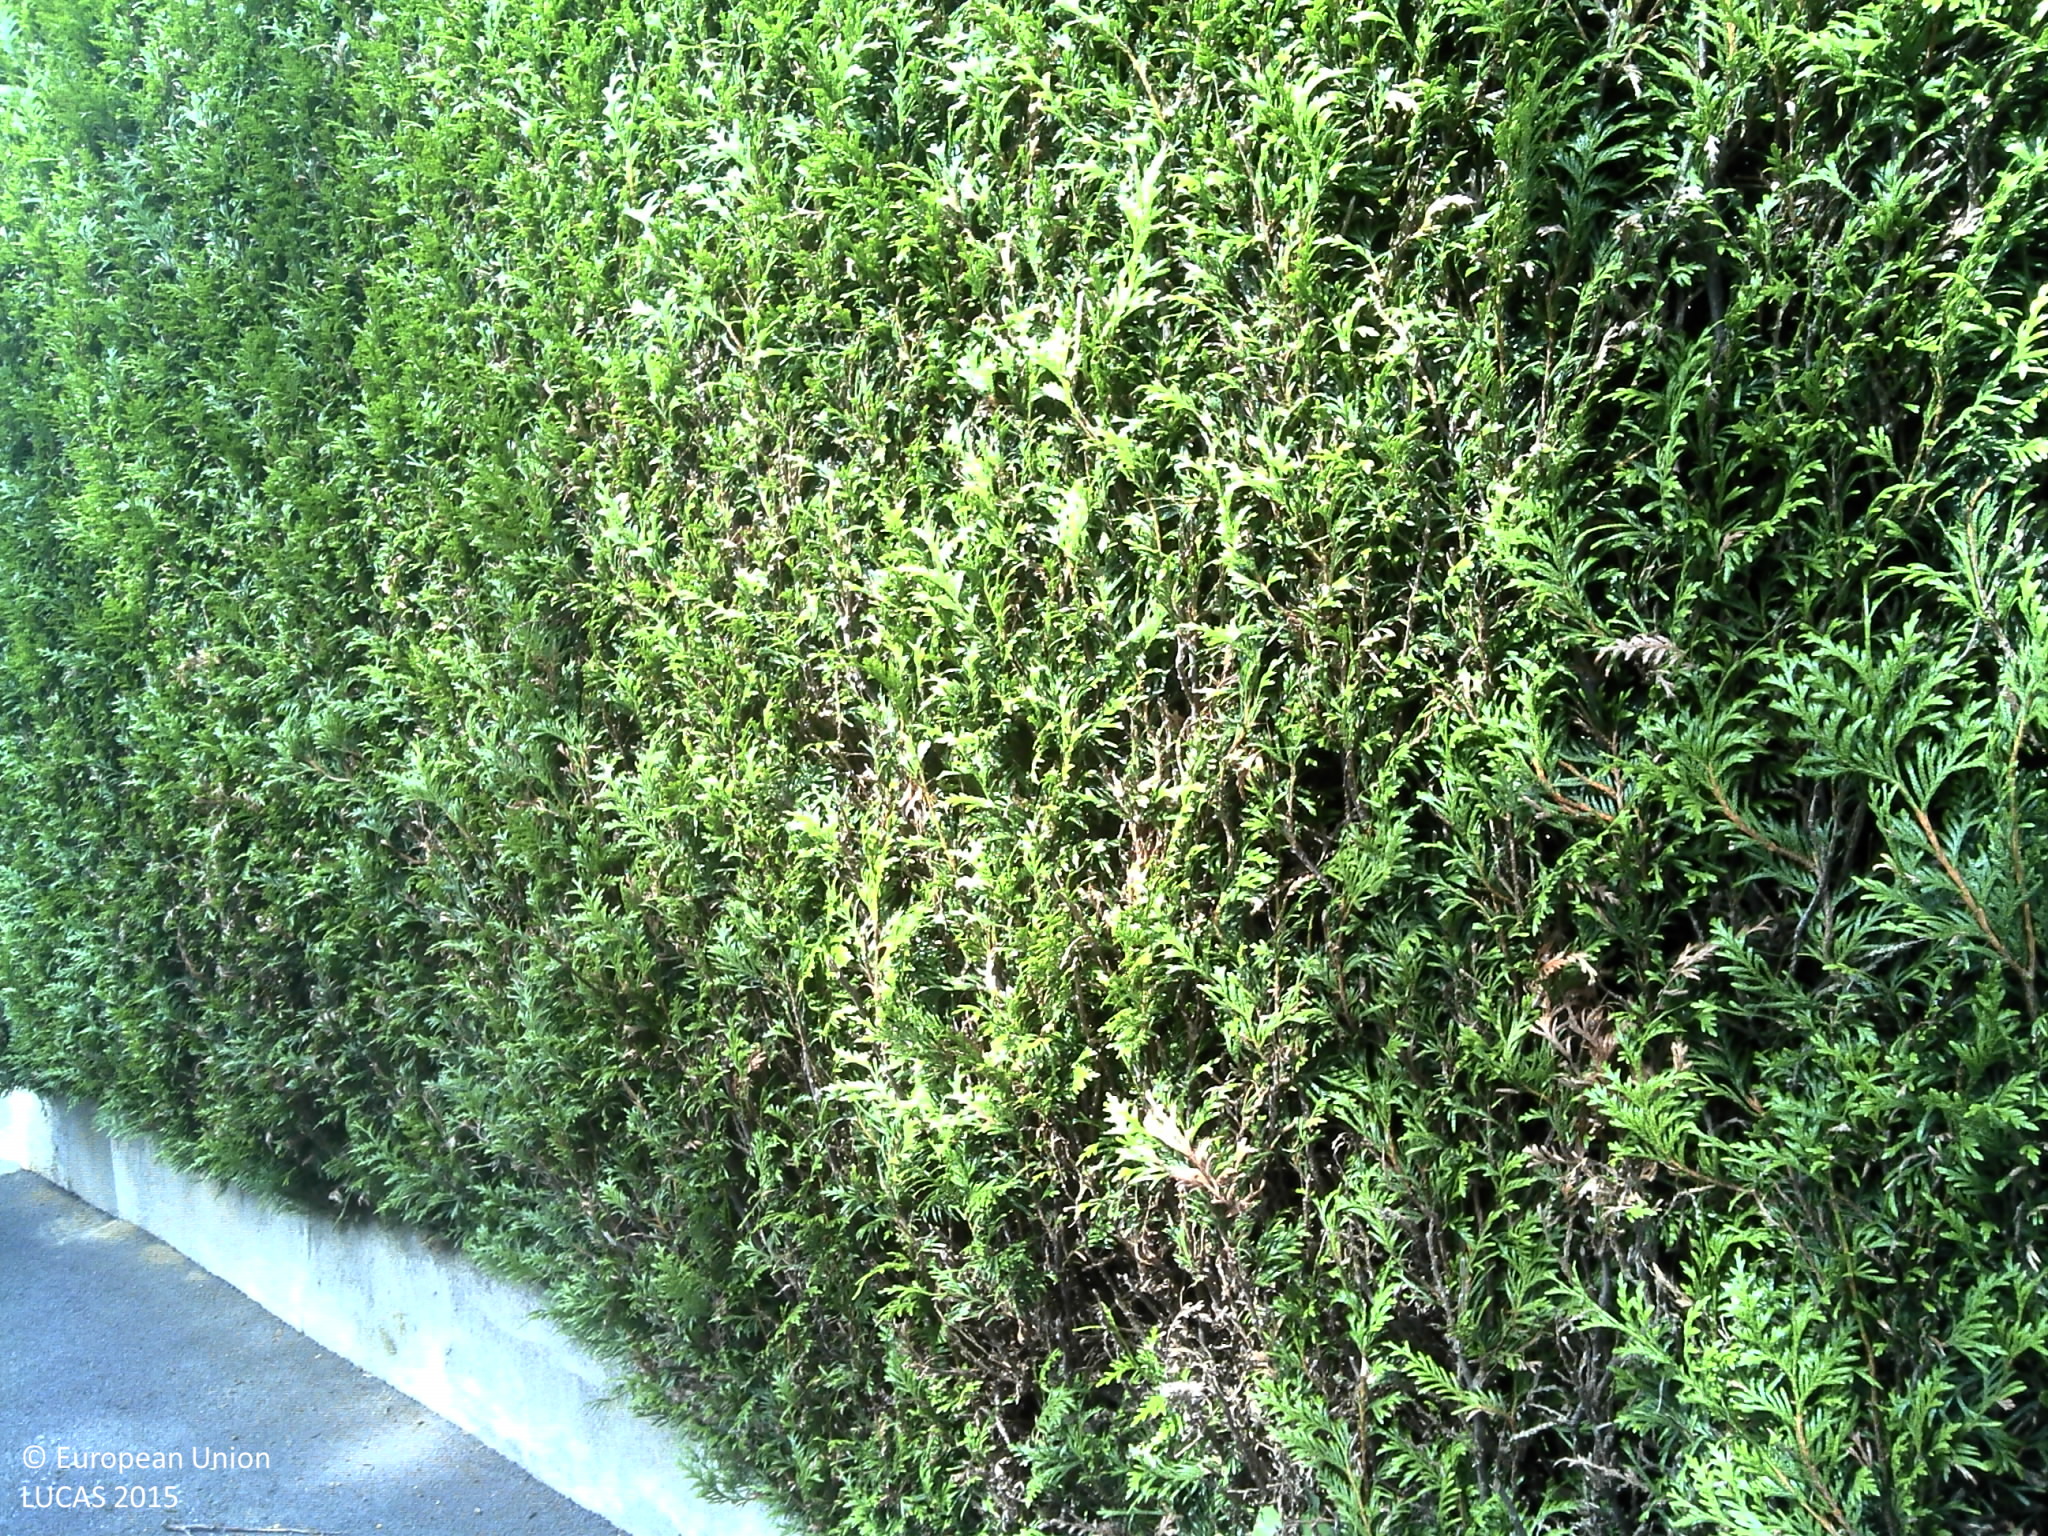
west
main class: Grassland
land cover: Grassland with sparse tree/shrub cover
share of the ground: > 75 %
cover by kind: herbaceous plants 95 %, broadleaved forest trees 5 %
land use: Residential
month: July
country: FR
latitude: 48.5796
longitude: 1.9479
